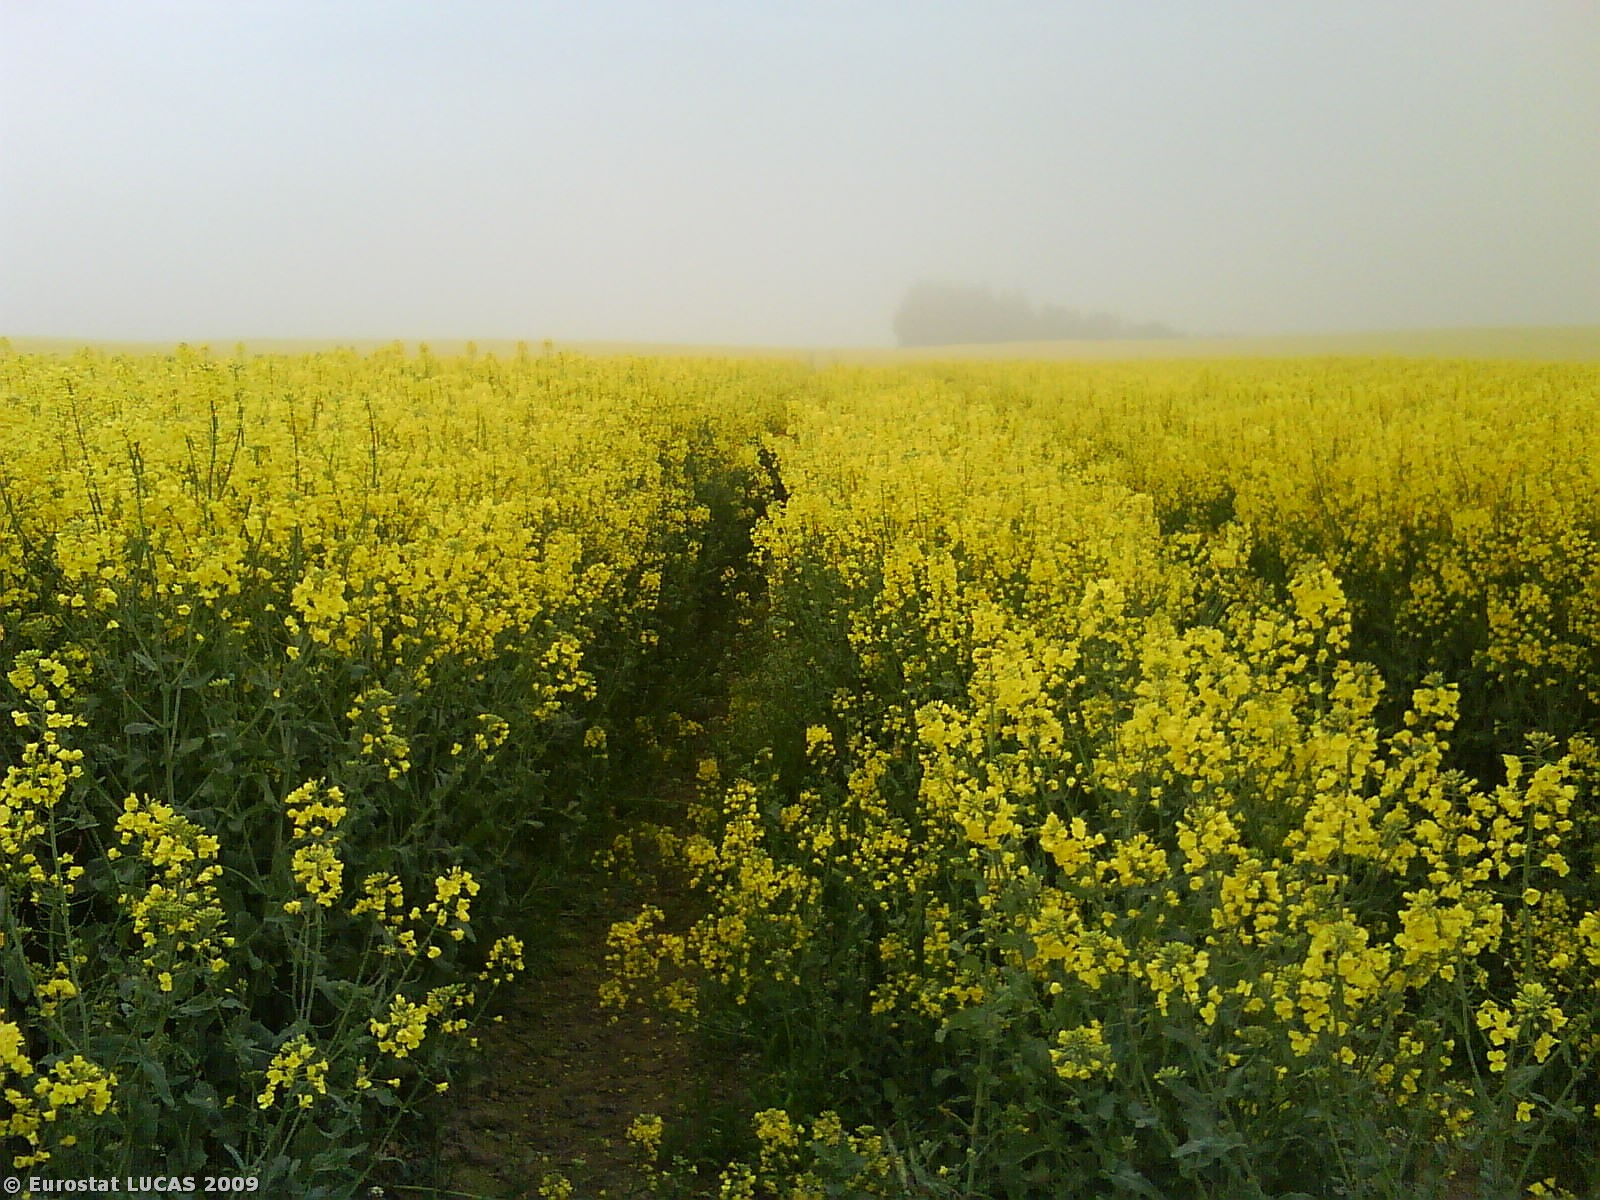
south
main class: Cropland
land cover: Rape and turnip rape
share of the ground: > 75 %
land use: Agriculture (excluding fallow land and kitchen gardens)
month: May
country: DK
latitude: 56.3492
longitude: 10.2747
